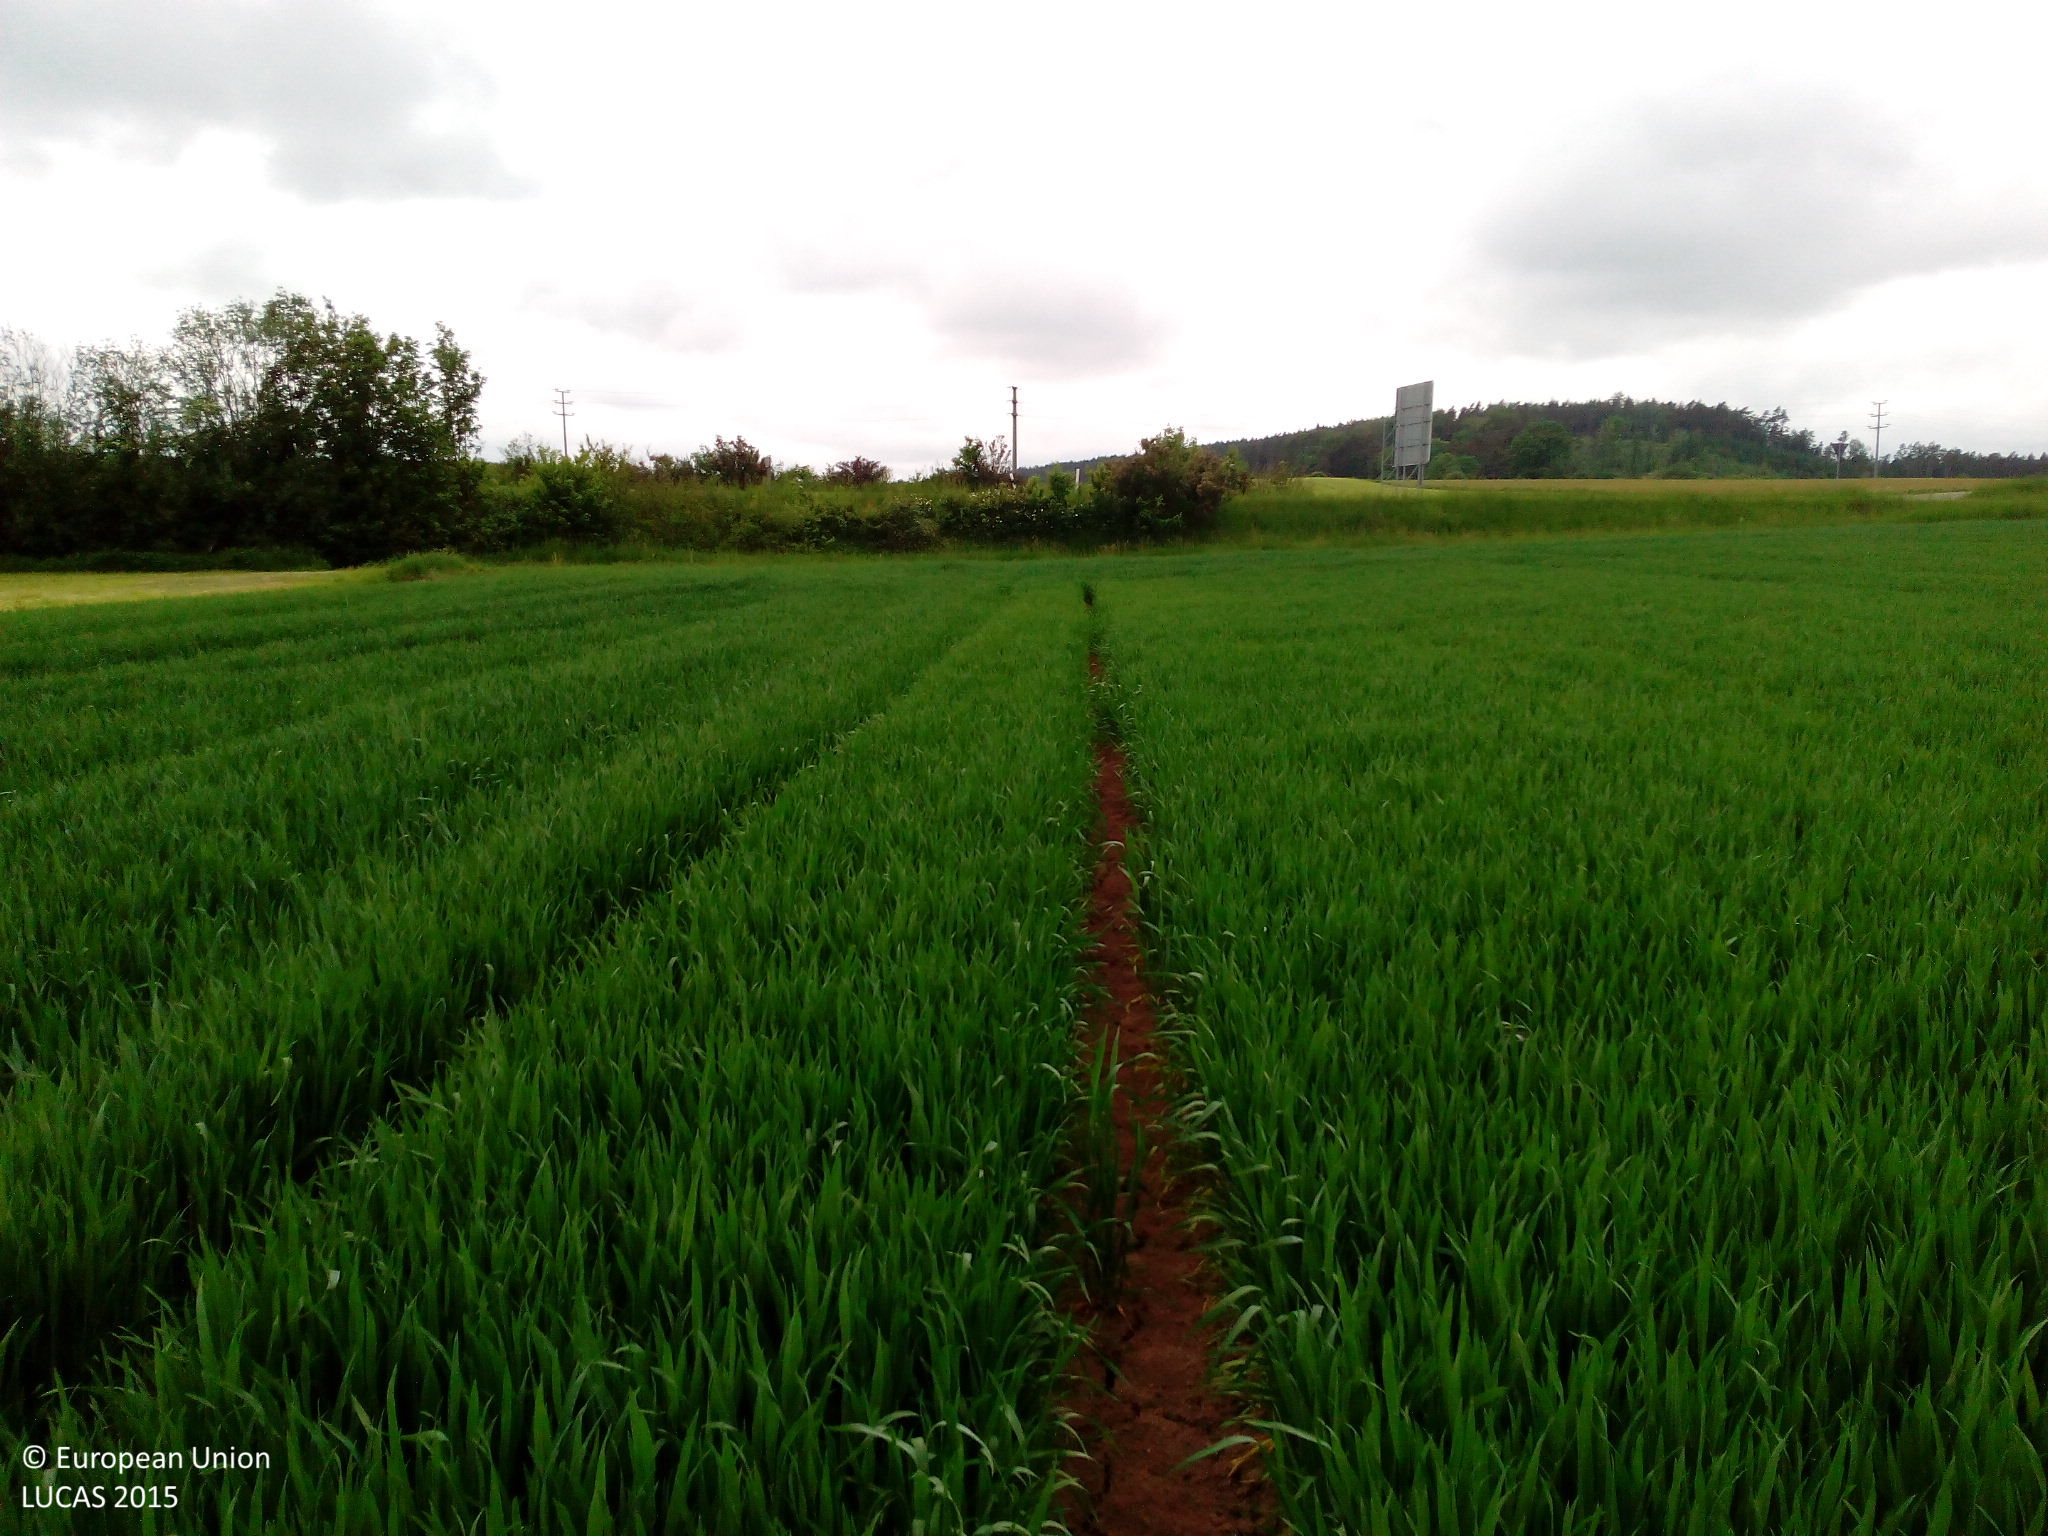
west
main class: Cropland
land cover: Common wheat
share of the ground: > 75 %
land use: Agriculture (excluding fallow land and kitchen gardens)
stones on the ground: < 10 %
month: May
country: DE
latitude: 49.1766
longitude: 10.3154
